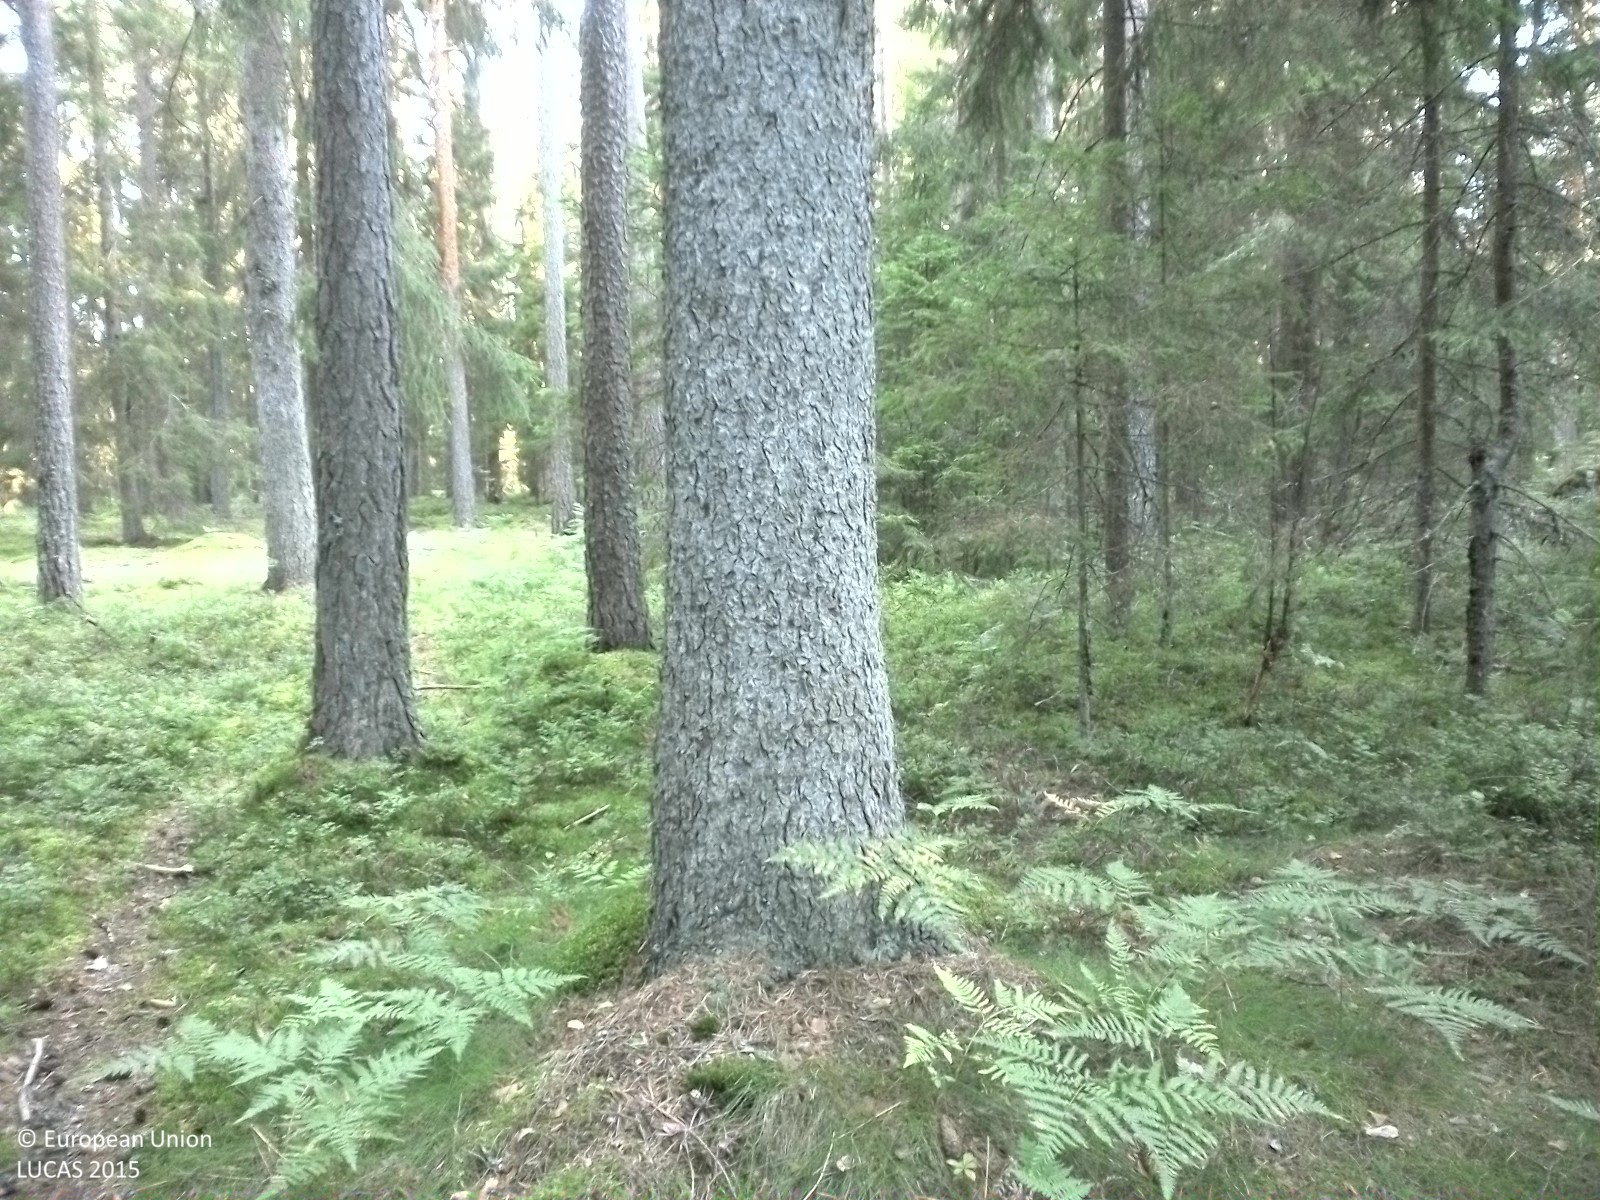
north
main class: Woodland
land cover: Other coniferous woodland
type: boreal forest
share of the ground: 25 - 50 %
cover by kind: coniferous forest trees 40 %, herbaceous plants 35 %, lichens and mosses 25 %
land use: Forestry
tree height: > 5 m
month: August
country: SE
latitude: 59.3306
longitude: 15.1061
